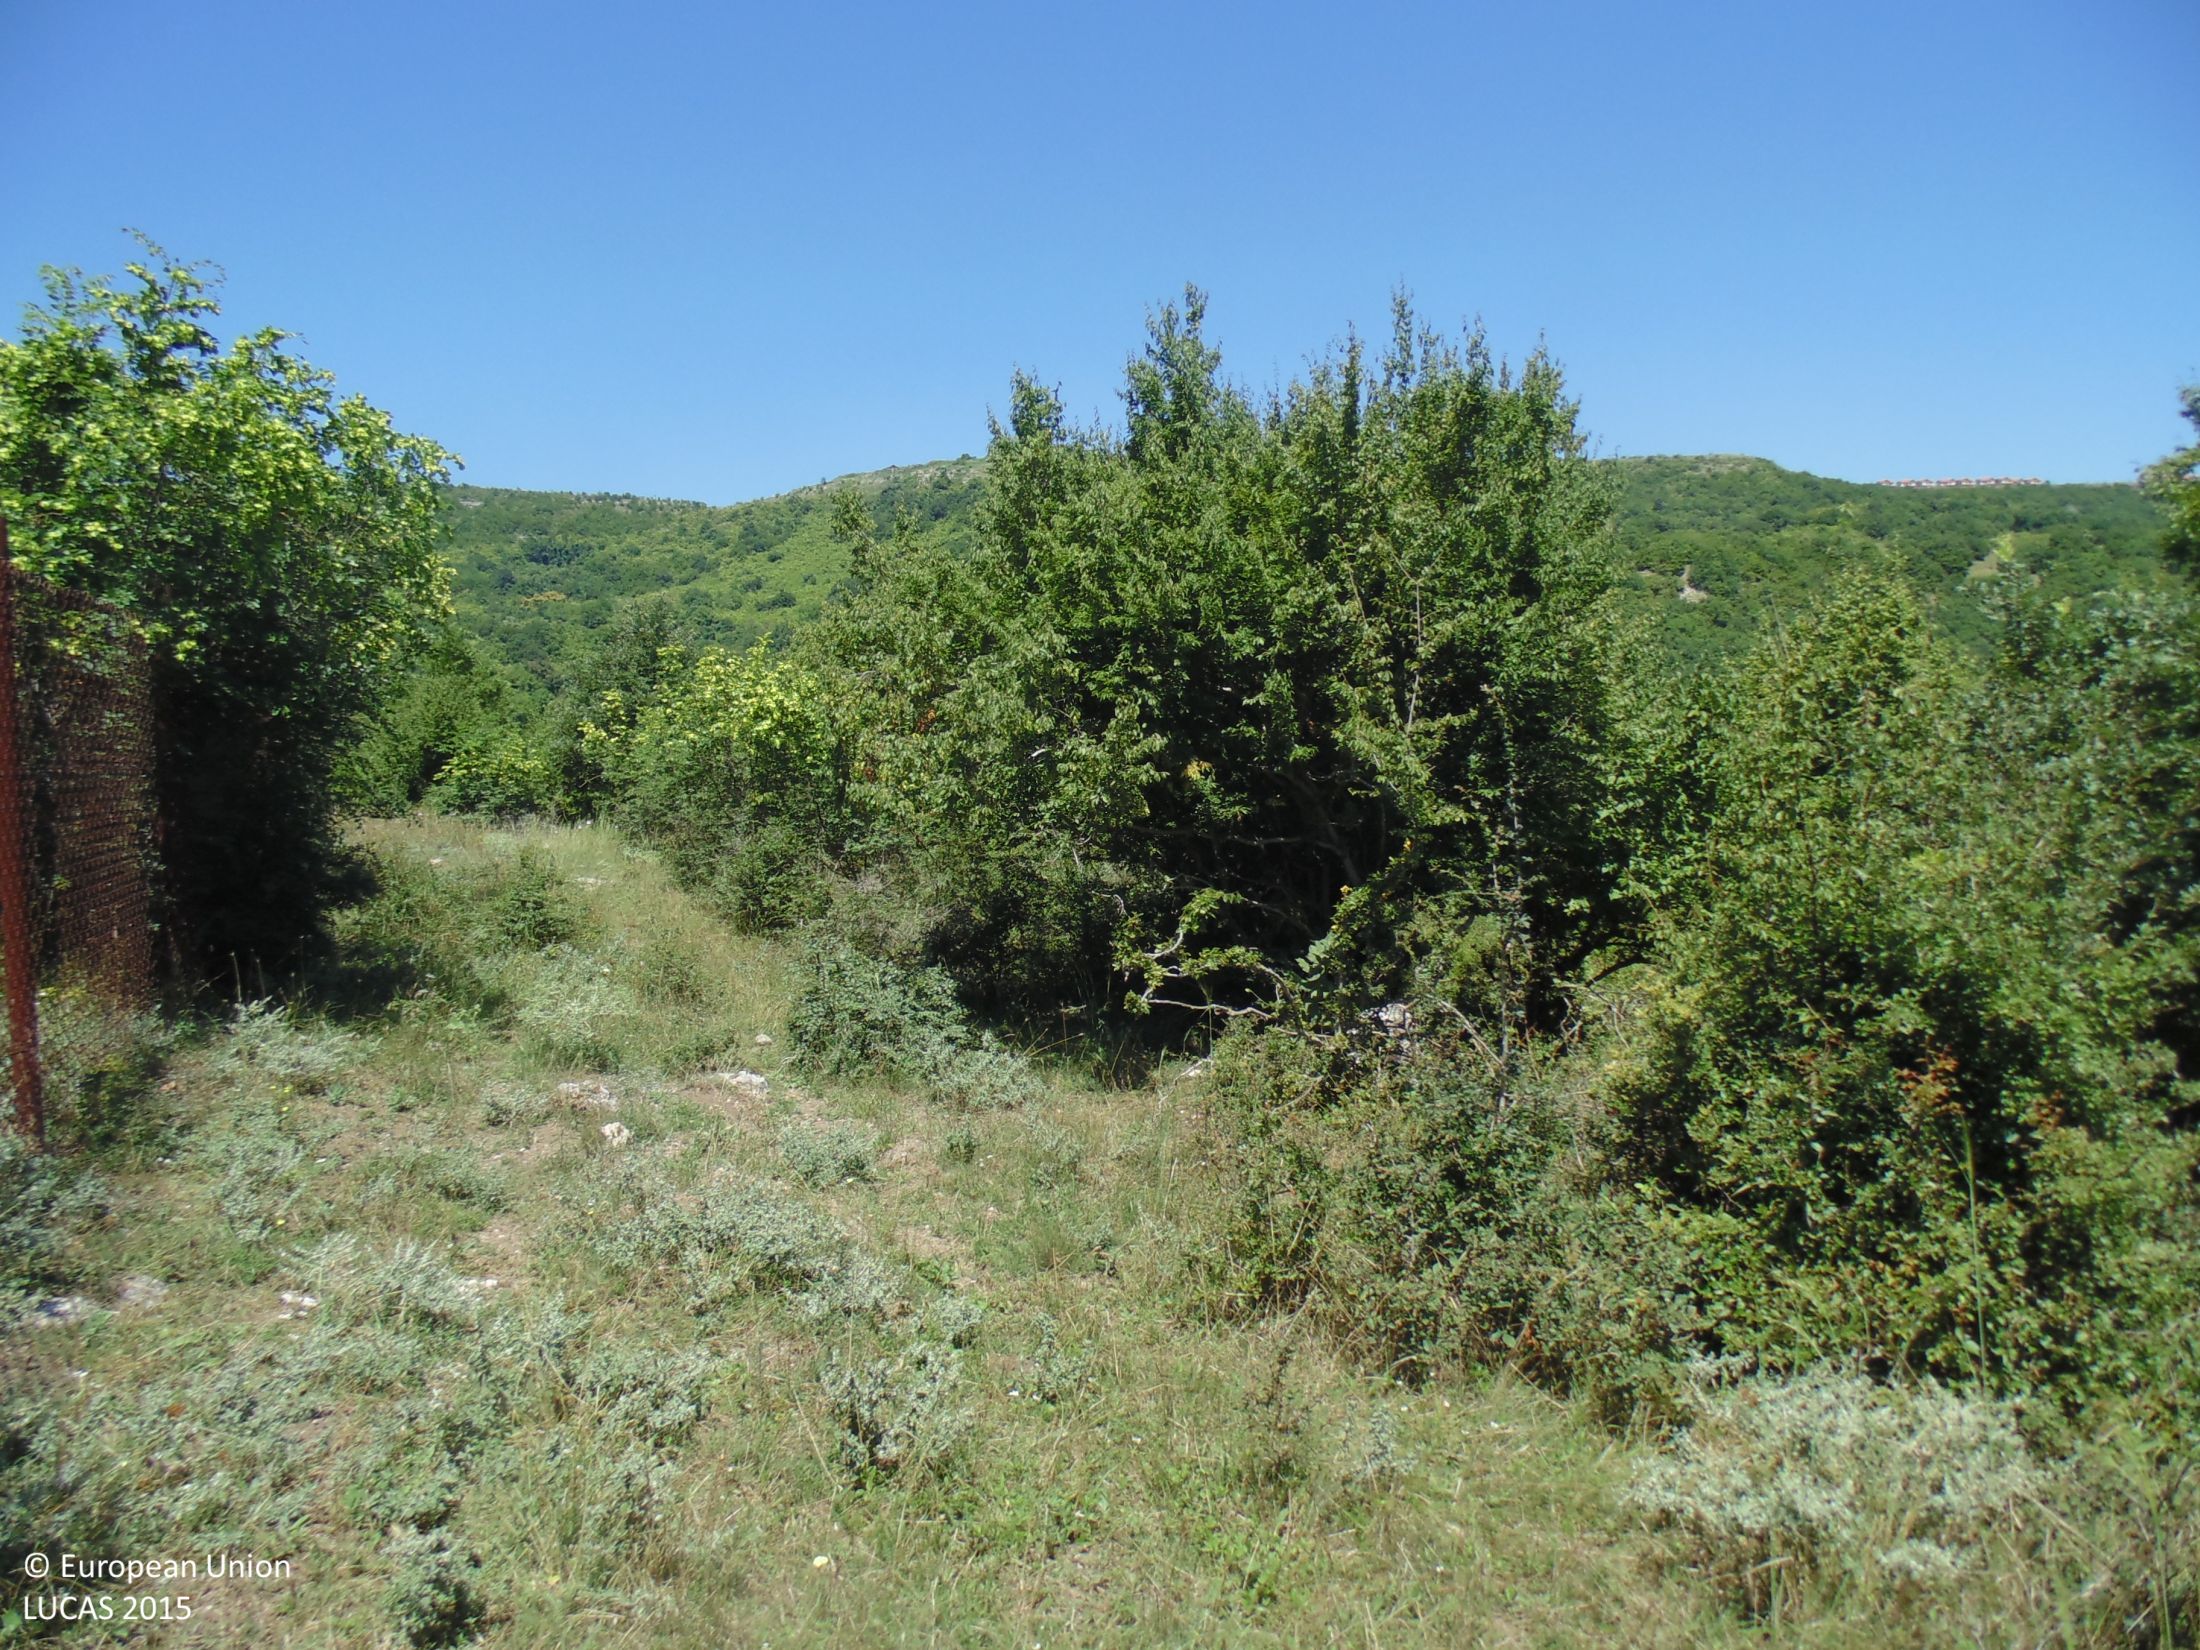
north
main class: Grassland
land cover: Grassland with sparse tree/shrub cover
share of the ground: > 75 %
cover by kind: herbaceous plants 90 %, broadleaved forest trees 5 %, shrubs 5 %
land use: Semi-natural and natural areas not in use
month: July
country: BG
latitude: 43.4171
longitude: 28.0417
